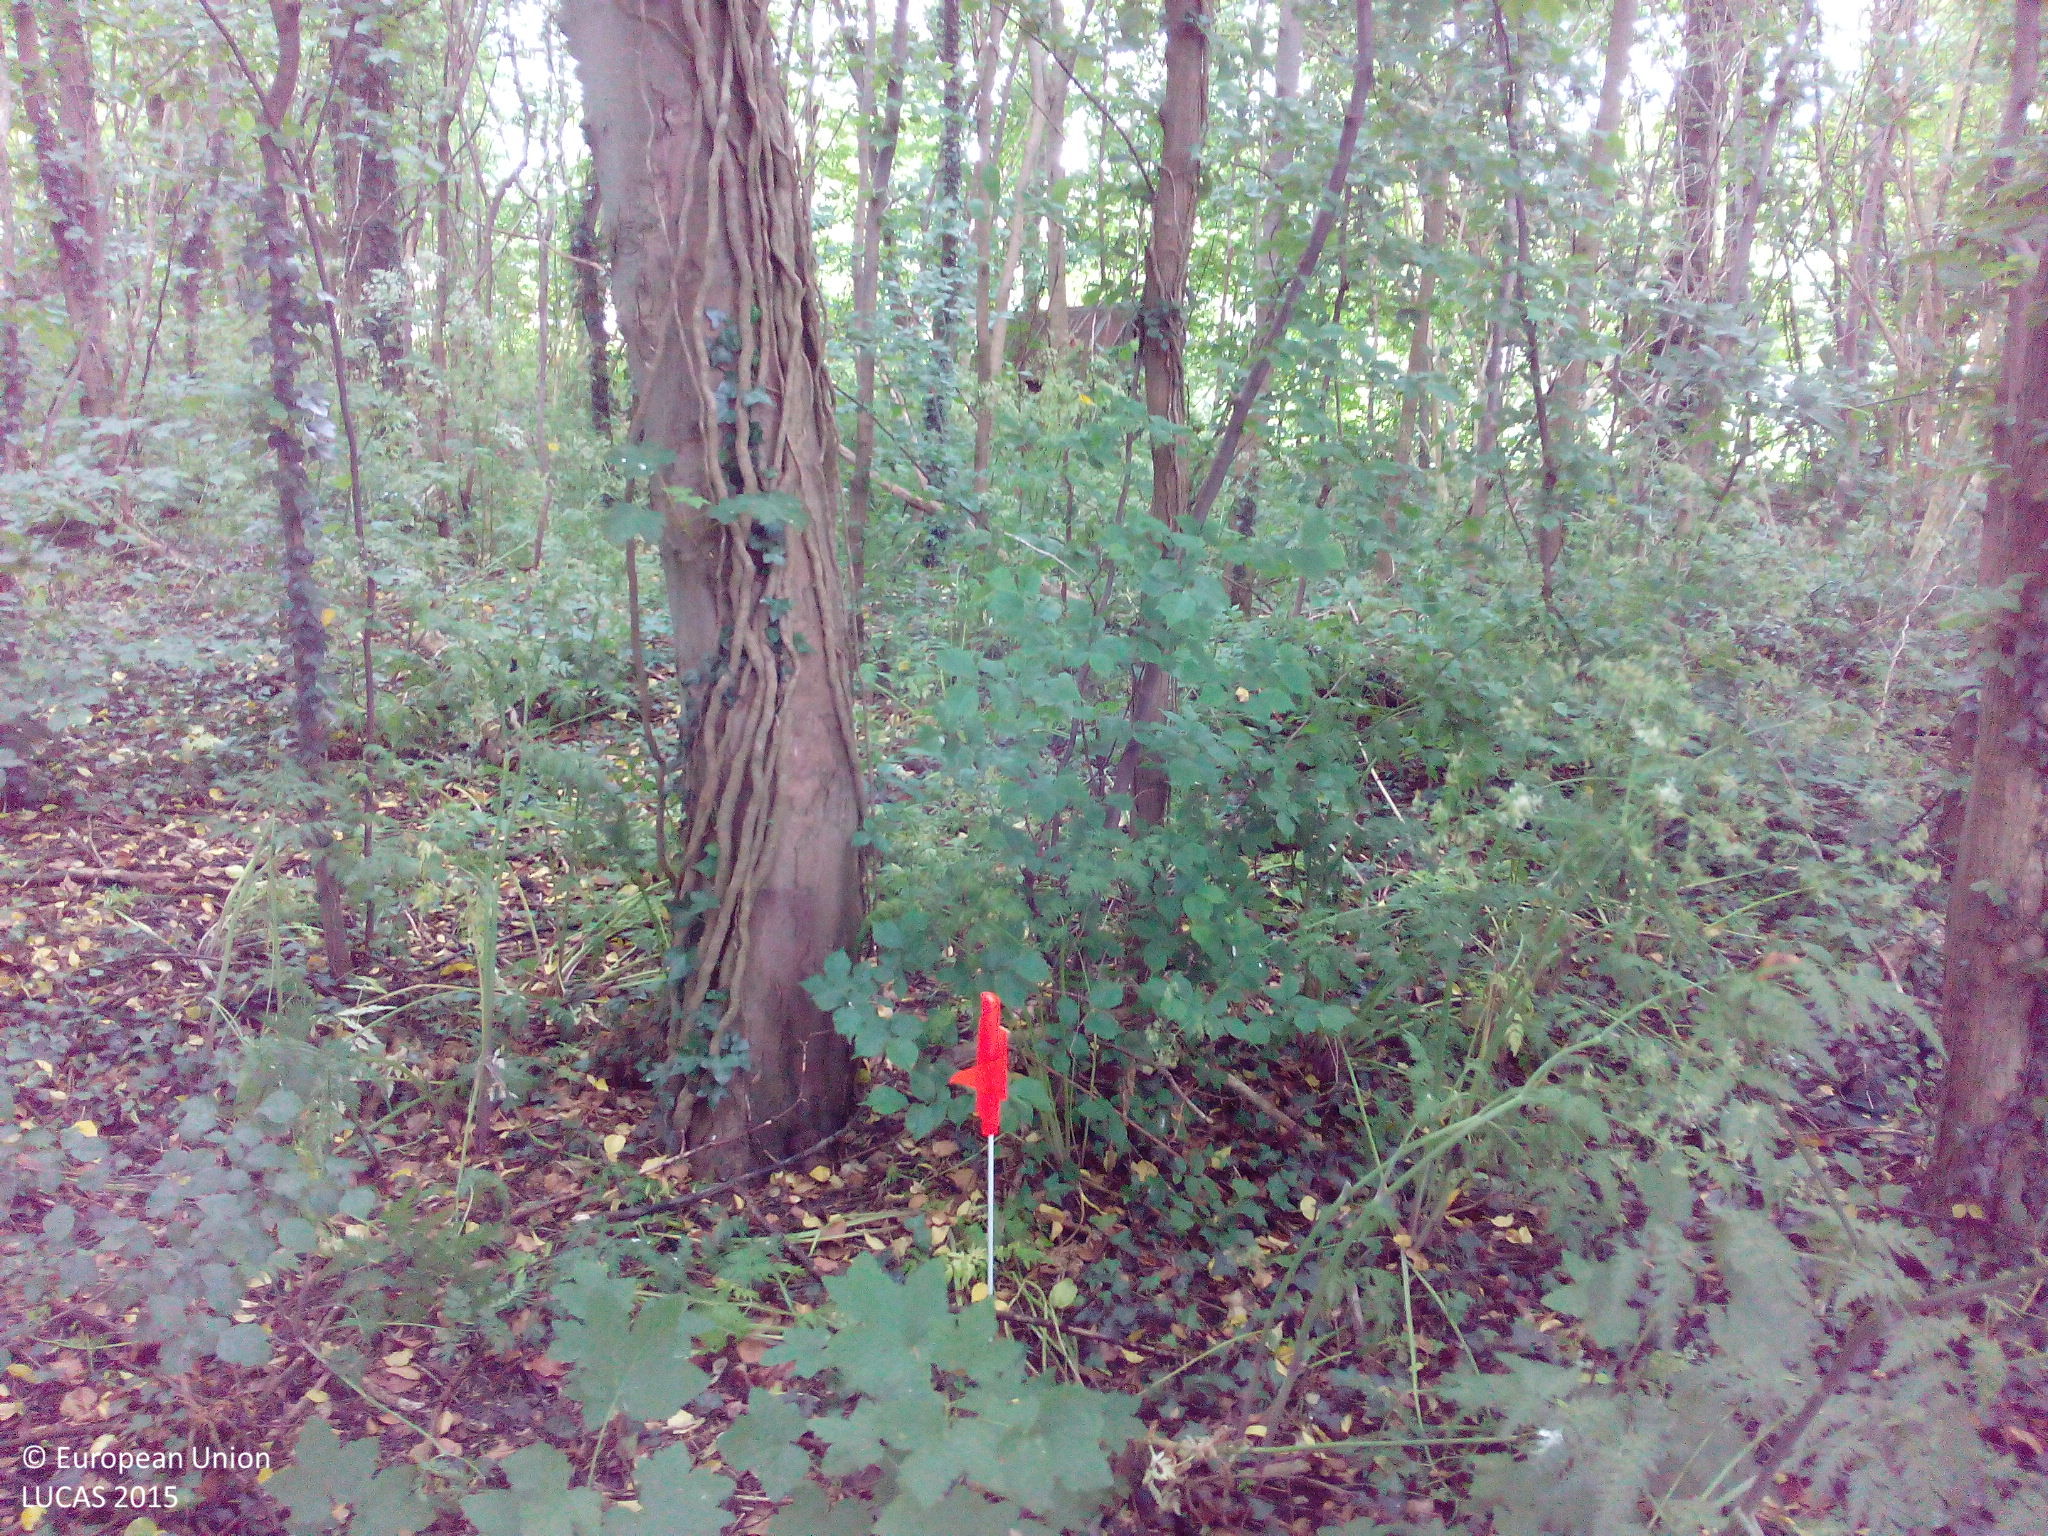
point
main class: Woodland
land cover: Broadleaved woodland
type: beech forest
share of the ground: > 75 %
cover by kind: broadleaved forest trees 100 %
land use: Residential
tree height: > 5 m
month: June
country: DK
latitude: 54.9452
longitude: 10.7644
